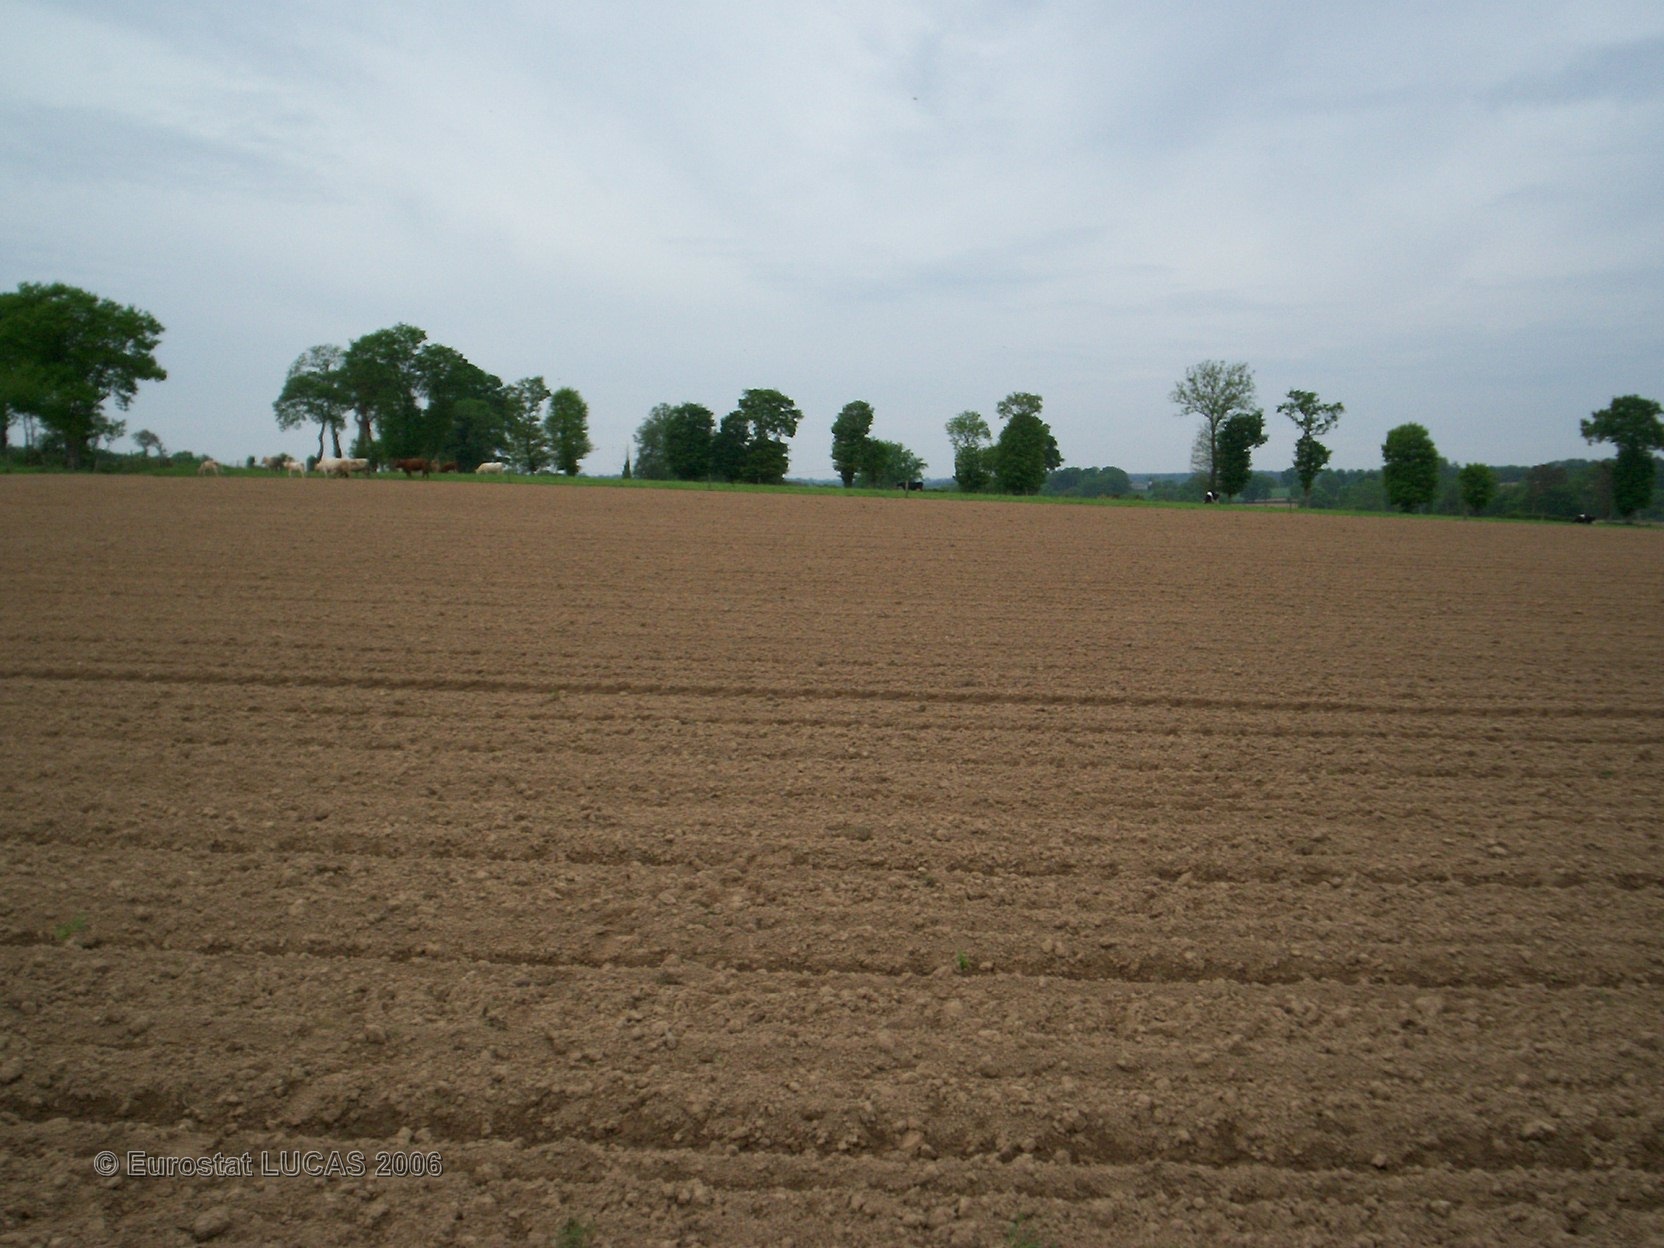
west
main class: Cropland
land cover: Maize
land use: Agriculture (excluding fallow land and kitchen gardens)
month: May
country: FR
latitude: 48.2584
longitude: -1.6457
